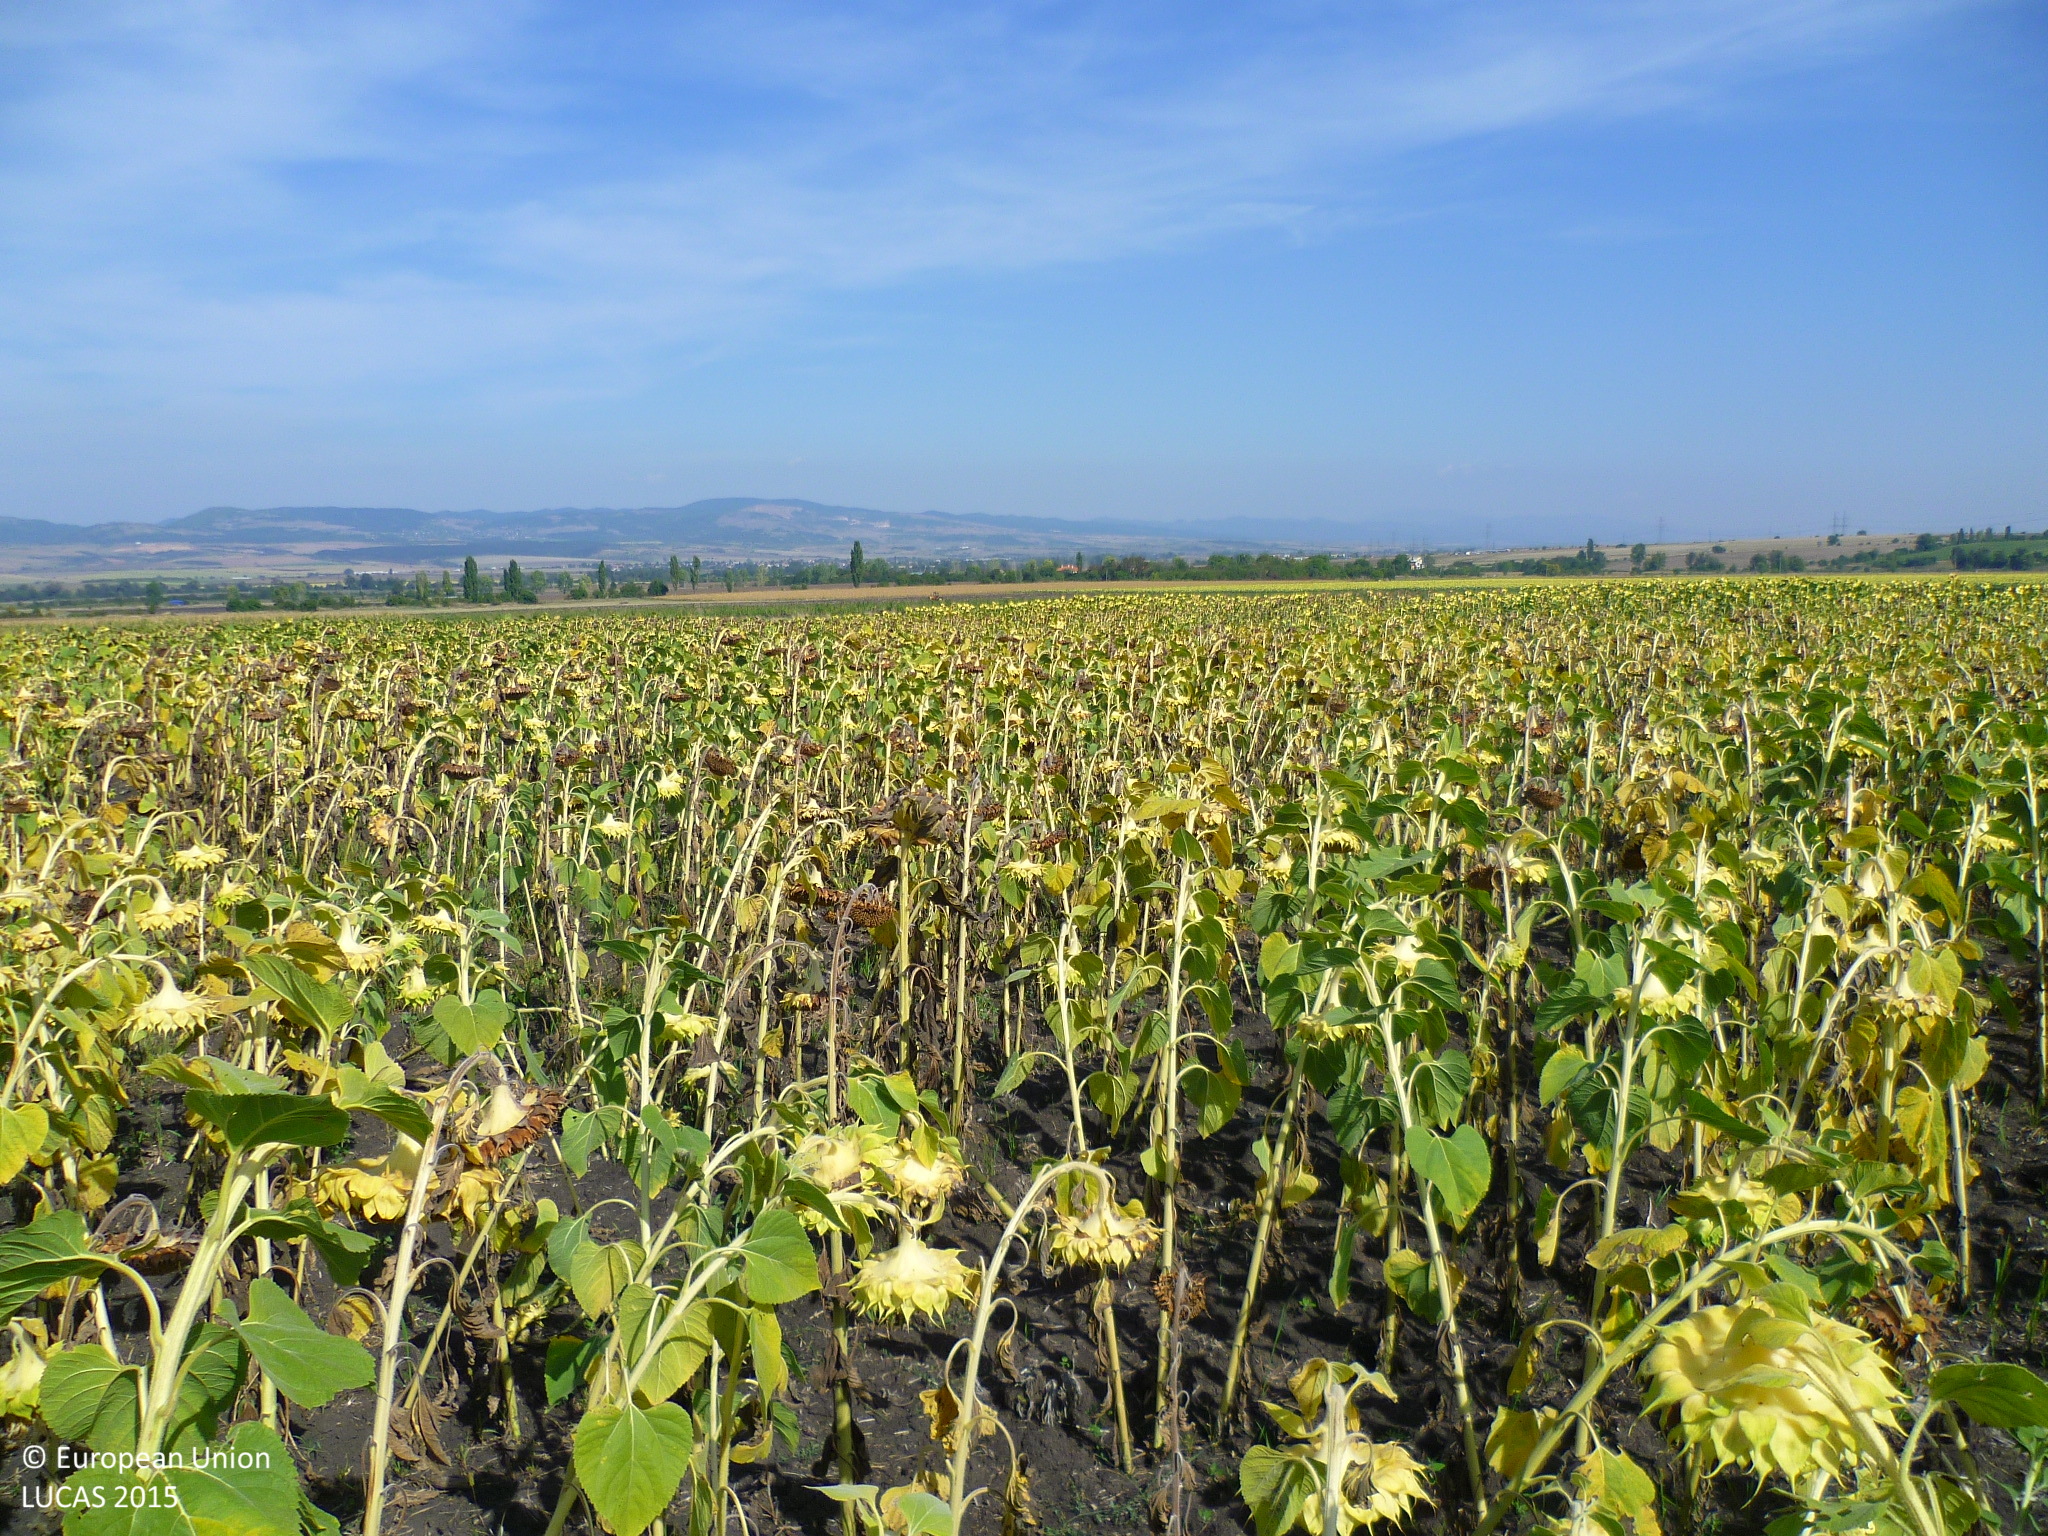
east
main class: Cropland
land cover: Sunflower
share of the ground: > 75 %
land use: Agriculture (excluding fallow land and kitchen gardens)
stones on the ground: < 10 %
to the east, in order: Sunflower; Tracks; Maize
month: December
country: BG
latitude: 42.8243
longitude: 23.0836
